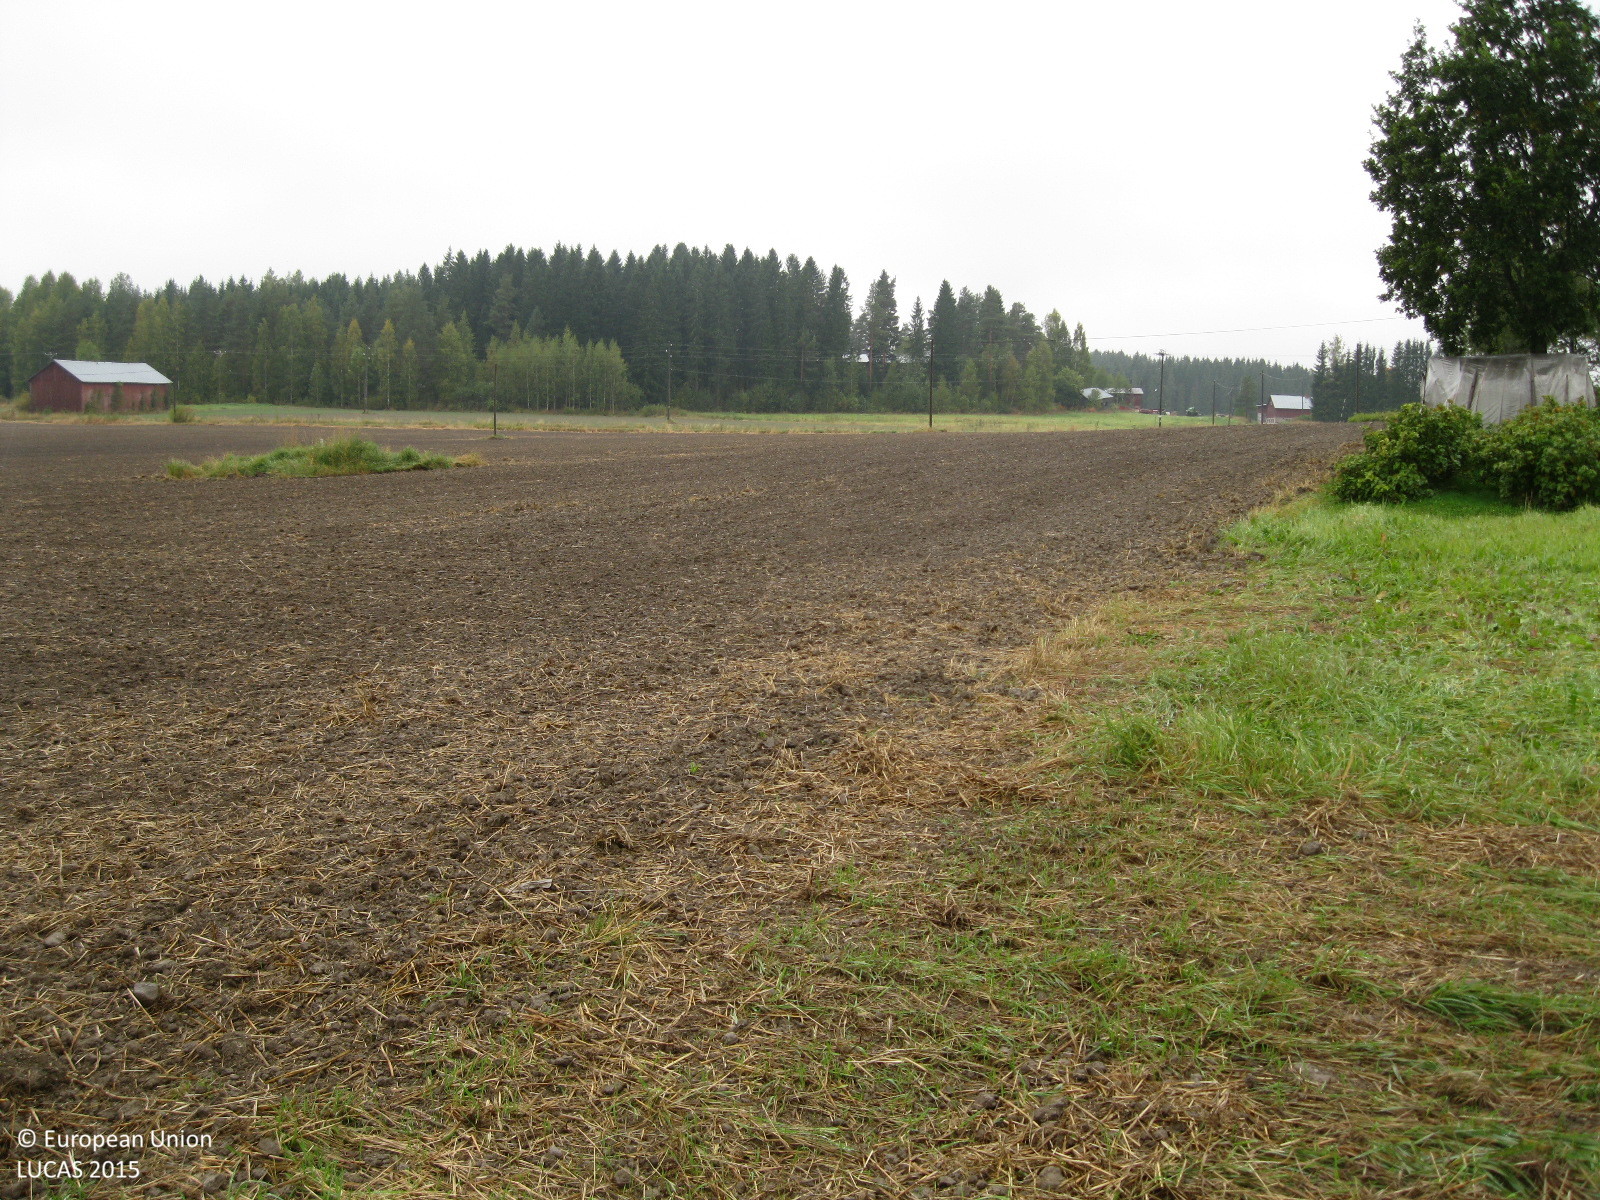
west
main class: Cropland
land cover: Temporary grasslands
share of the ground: > 75 %
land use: Agriculture (excluding fallow land and kitchen gardens)
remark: Harvested field
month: September
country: FI
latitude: 60.9087
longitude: 25.0690
